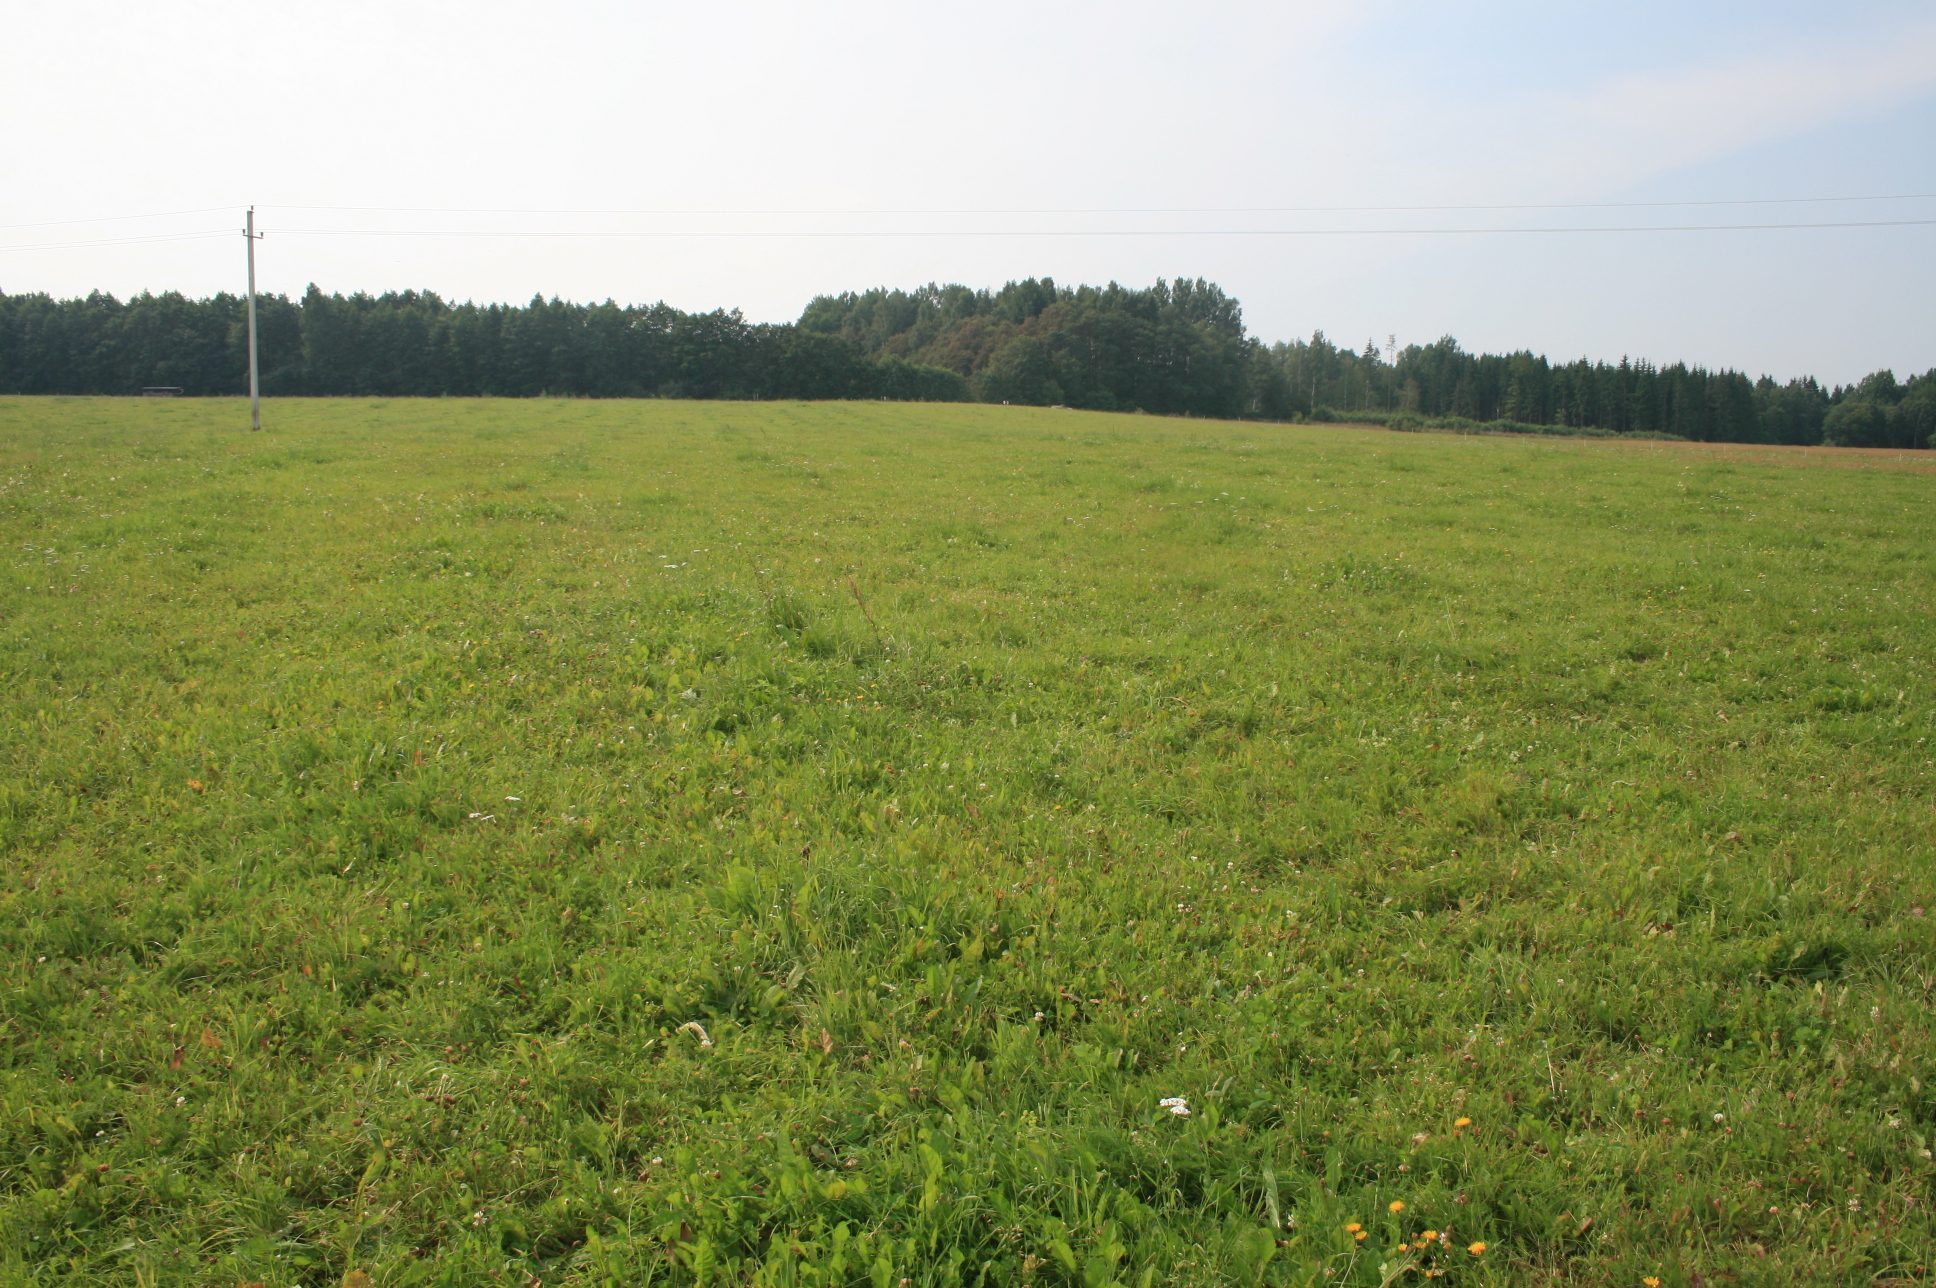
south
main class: Grassland
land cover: Grassland without tree/shrub cover
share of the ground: > 75 %
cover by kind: herbaceous plants 100 %
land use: Agriculture (excluding fallow land and kitchen gardens)
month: August
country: LT
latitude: 55.5800
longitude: 21.8687
